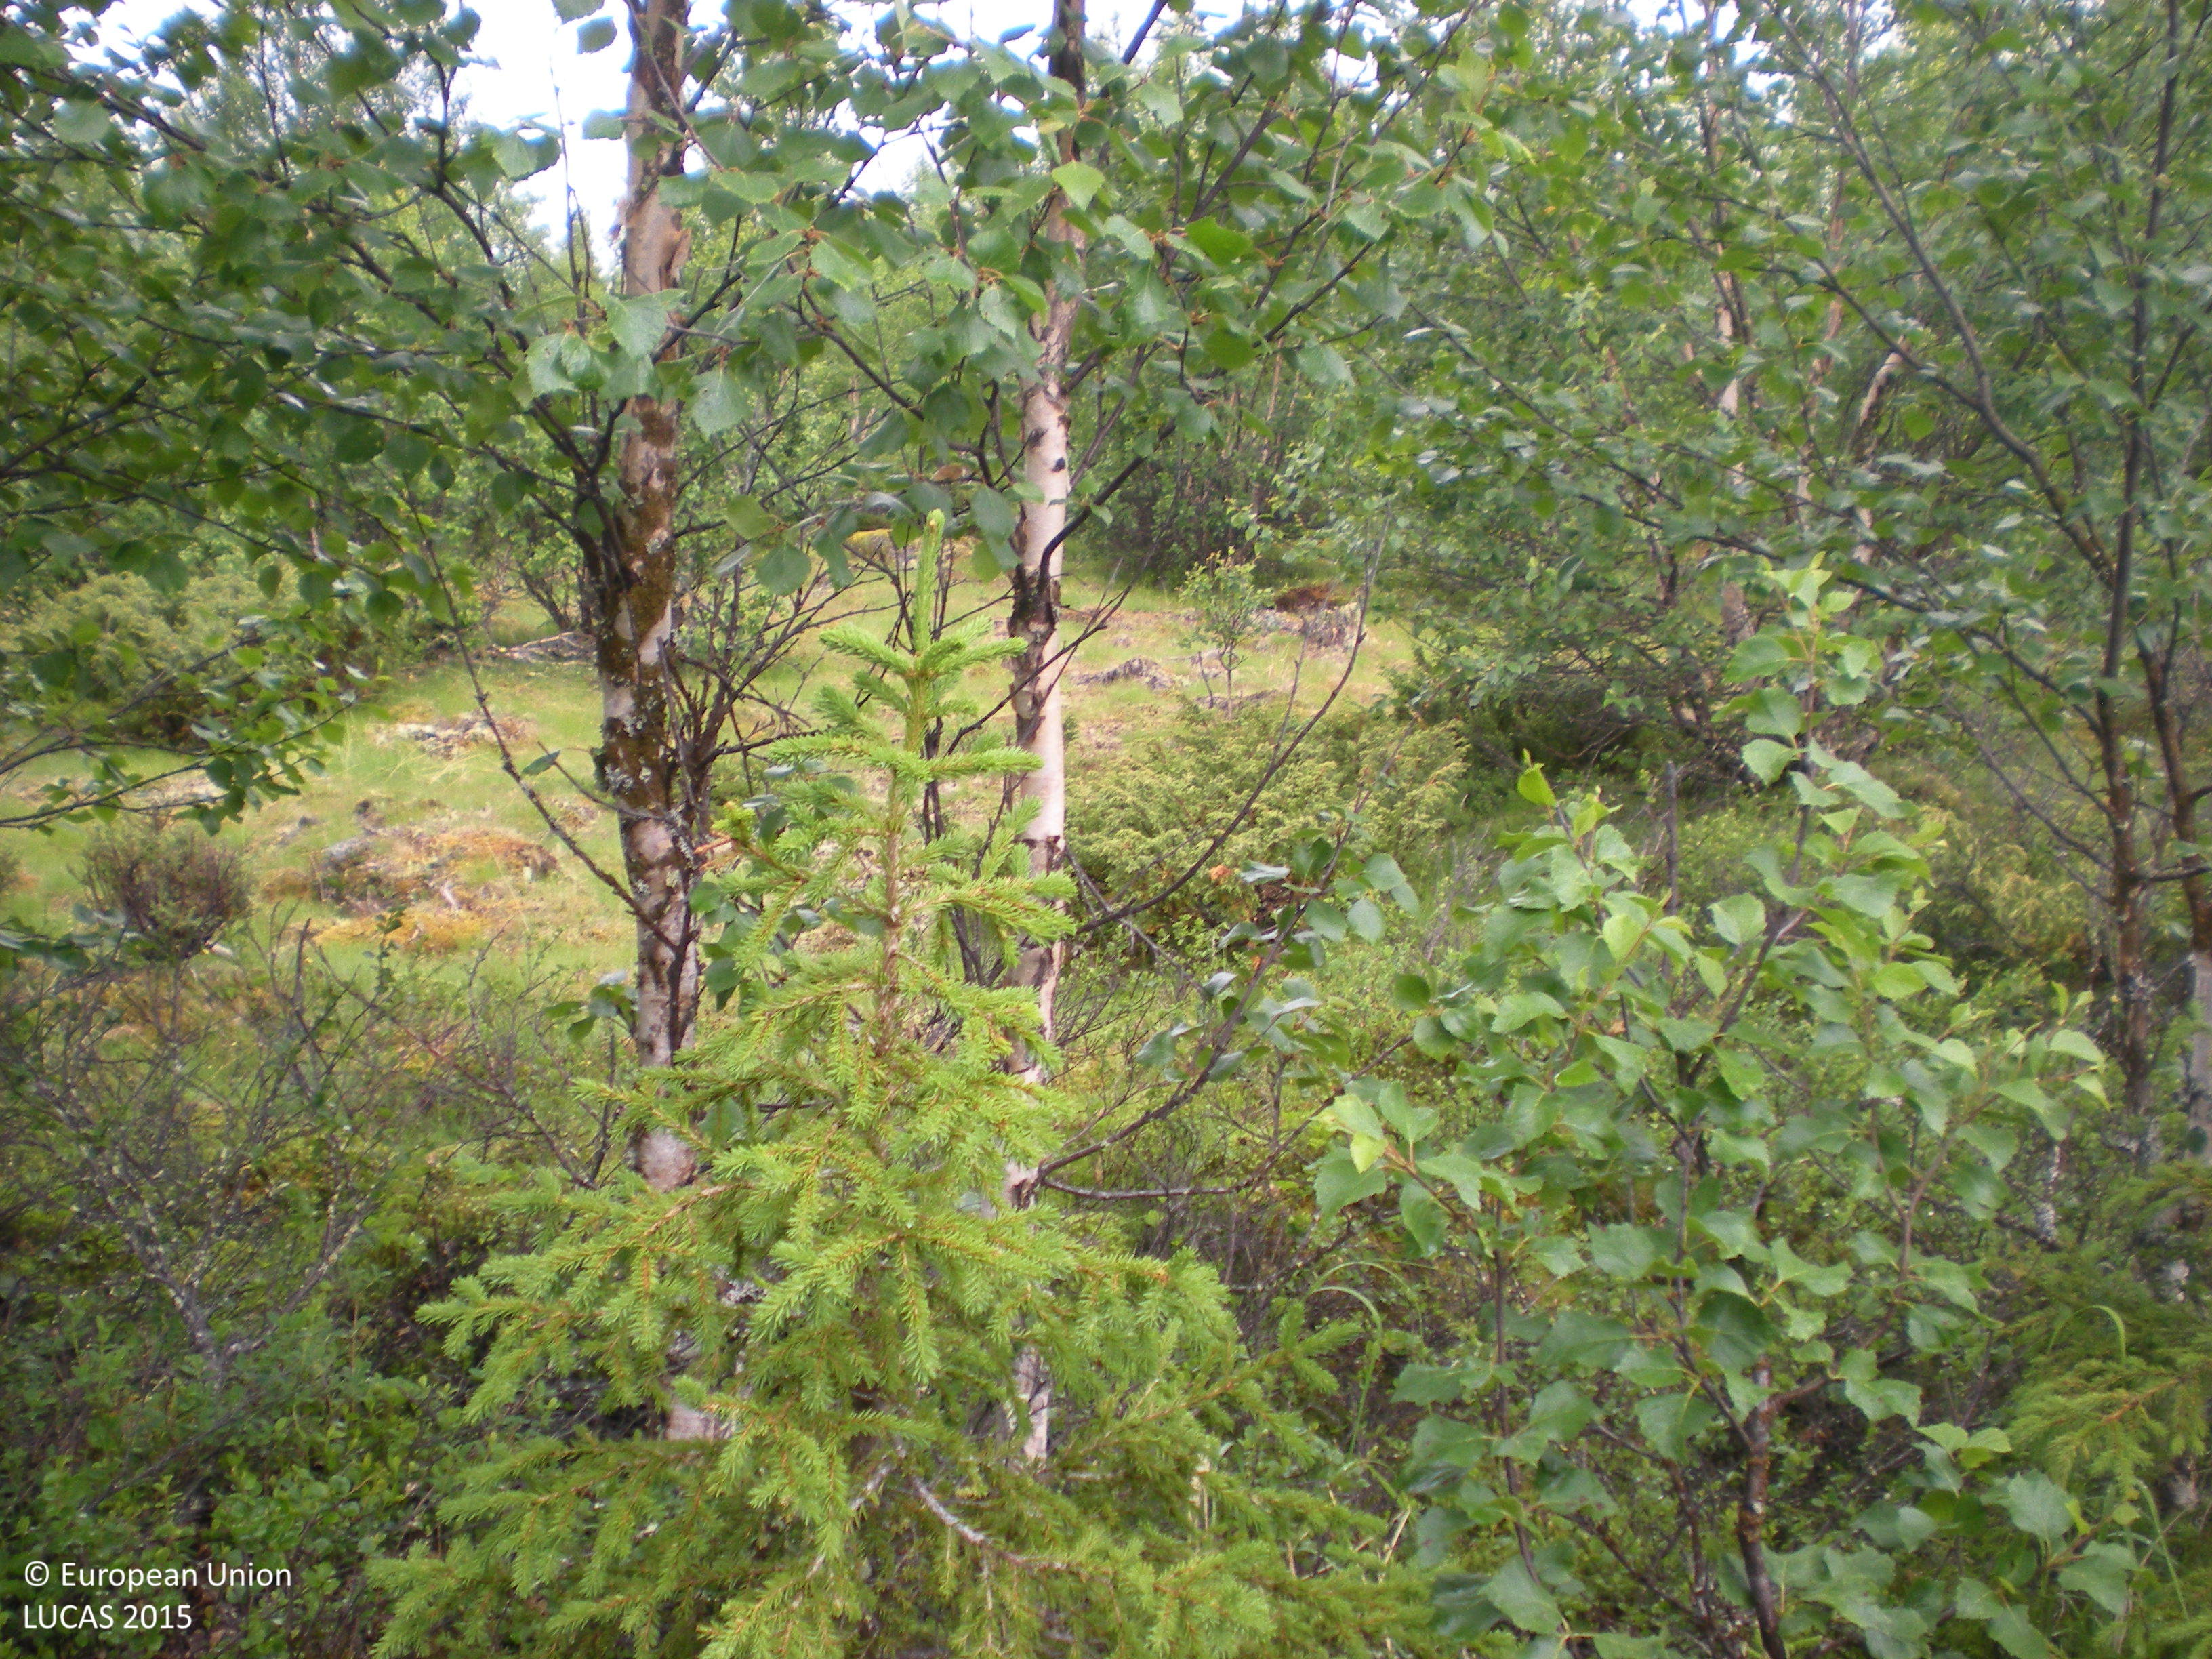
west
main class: Woodland
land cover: Spruce dominated mixed woodland
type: boreal forest
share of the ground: 50 - 75 %
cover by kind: broadleaved forest trees 55 %, coniferous forest trees 20 %, herbaceous plants 10 %, lichens and mosses 10 %, shrubs 5 %
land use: Forestry
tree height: > 5 m
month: July
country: SE
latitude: 65.7765
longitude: 17.2315
